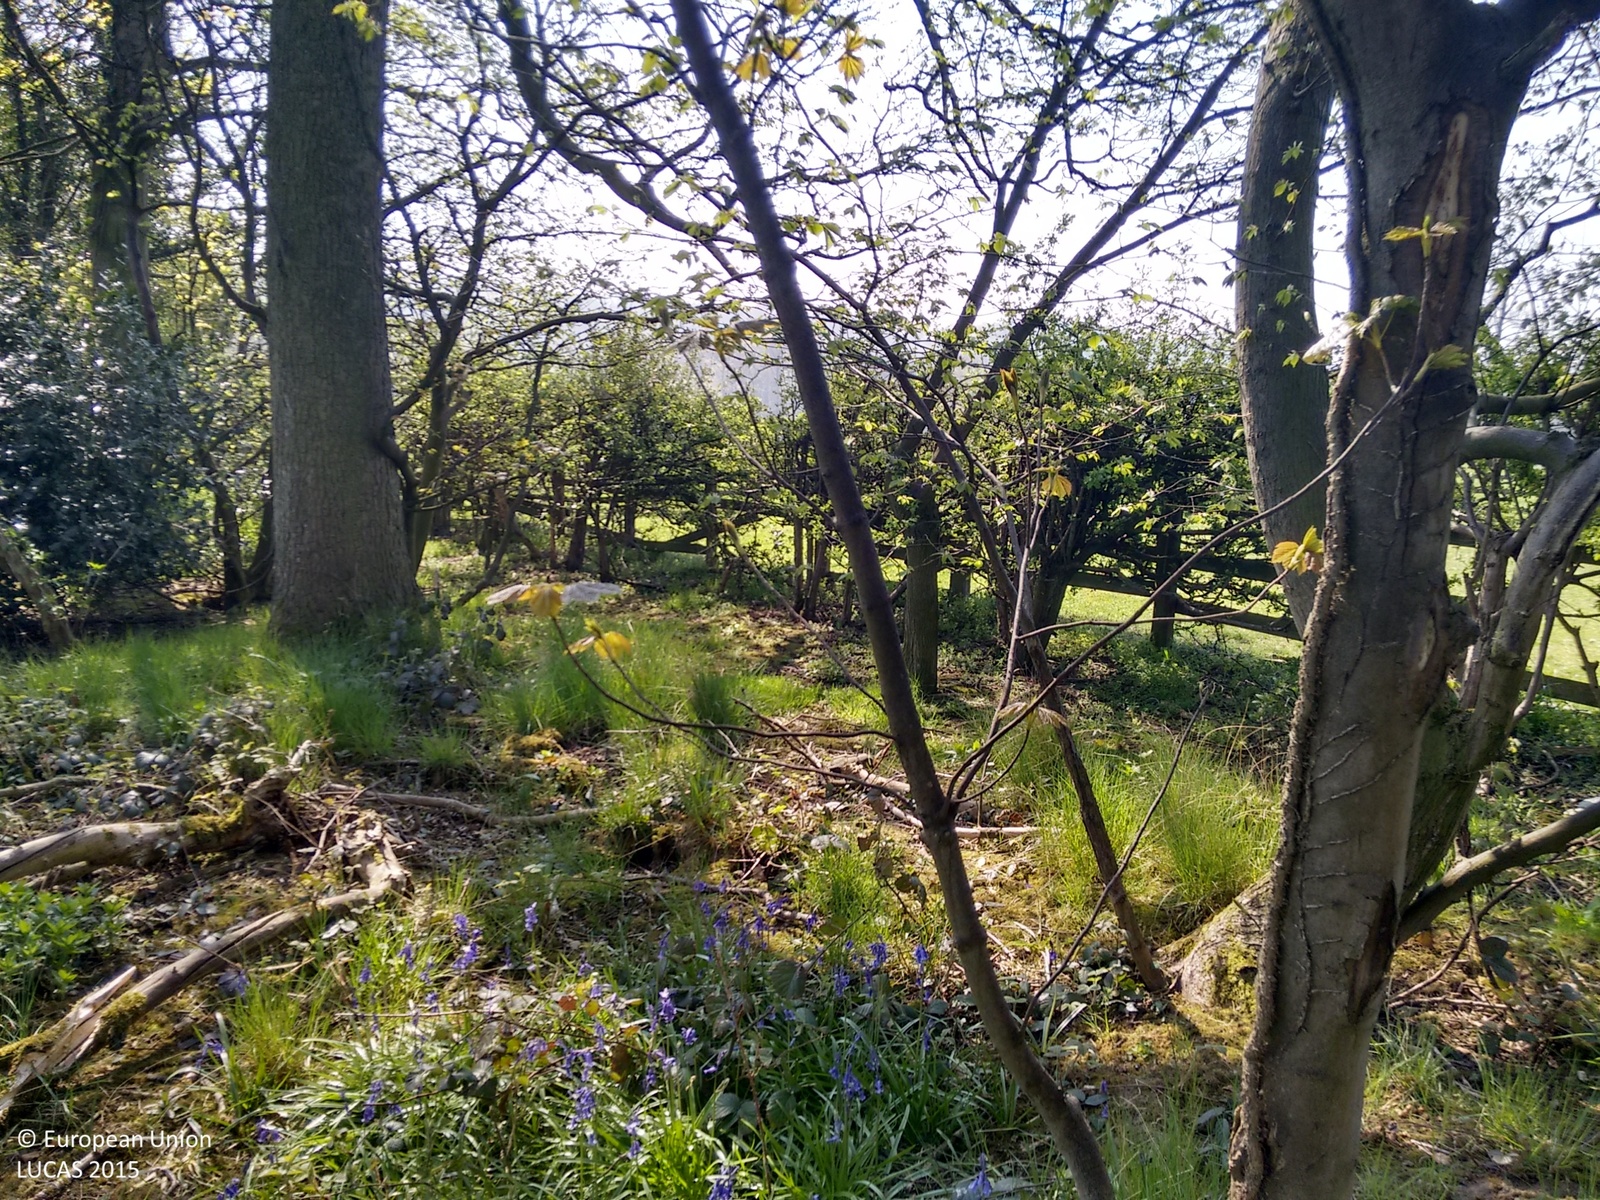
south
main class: Woodland
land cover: Broadleaved woodland
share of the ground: > 75 %
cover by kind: broadleaved forest trees 100 %
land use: Agriculture (excluding fallow land and kitchen gardens)
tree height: > 5 m
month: April
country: GB
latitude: 53.8962
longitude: -1.6013
